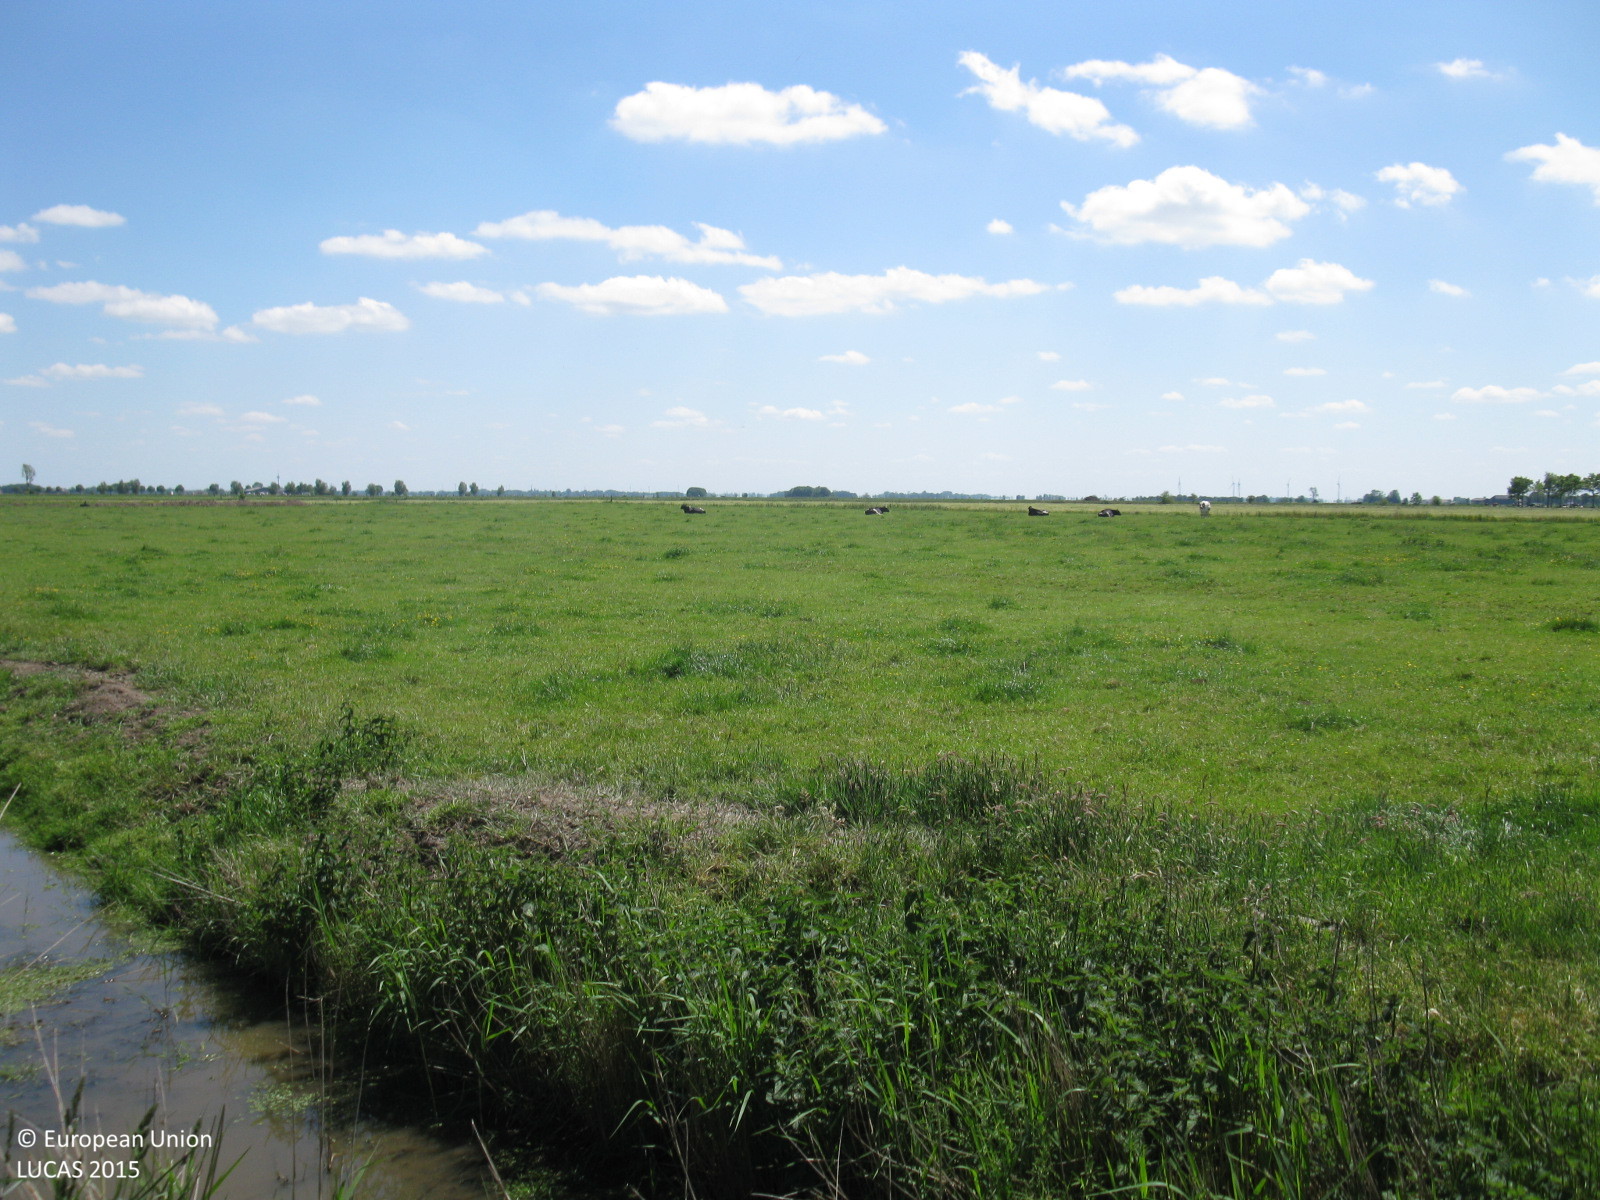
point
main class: Grassland
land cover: Grassland without tree/shrub cover
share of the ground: > 75 %
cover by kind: herbaceous plants 100 %
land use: Agriculture (excluding fallow land and kitchen gardens)
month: June
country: DE
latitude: 53.2996
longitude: 7.2847
